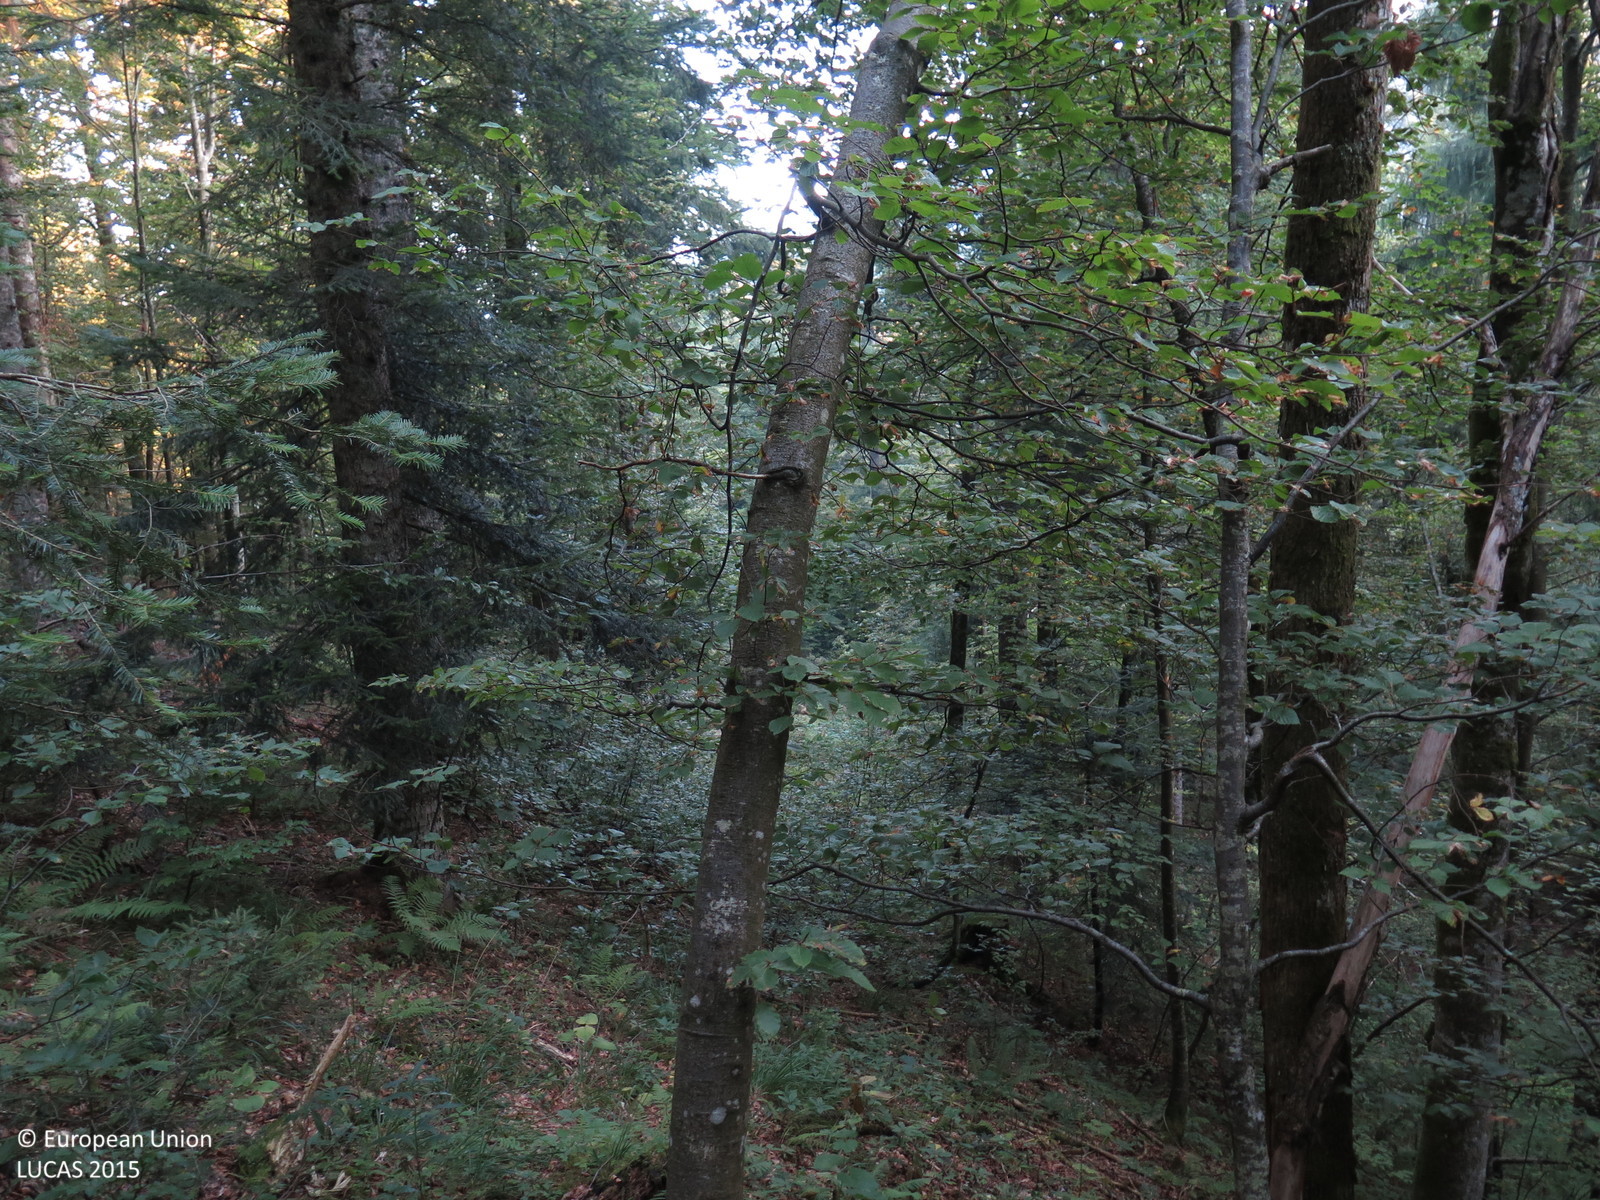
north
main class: Woodland
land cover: Other mixed woodland
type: mountainous beech forest
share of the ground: > 75 %
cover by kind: broadleaved forest trees 75 %, coniferous forest trees 25 %
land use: Forestry
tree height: > 5 m
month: August
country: HR
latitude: 45.2978
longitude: 14.9557
